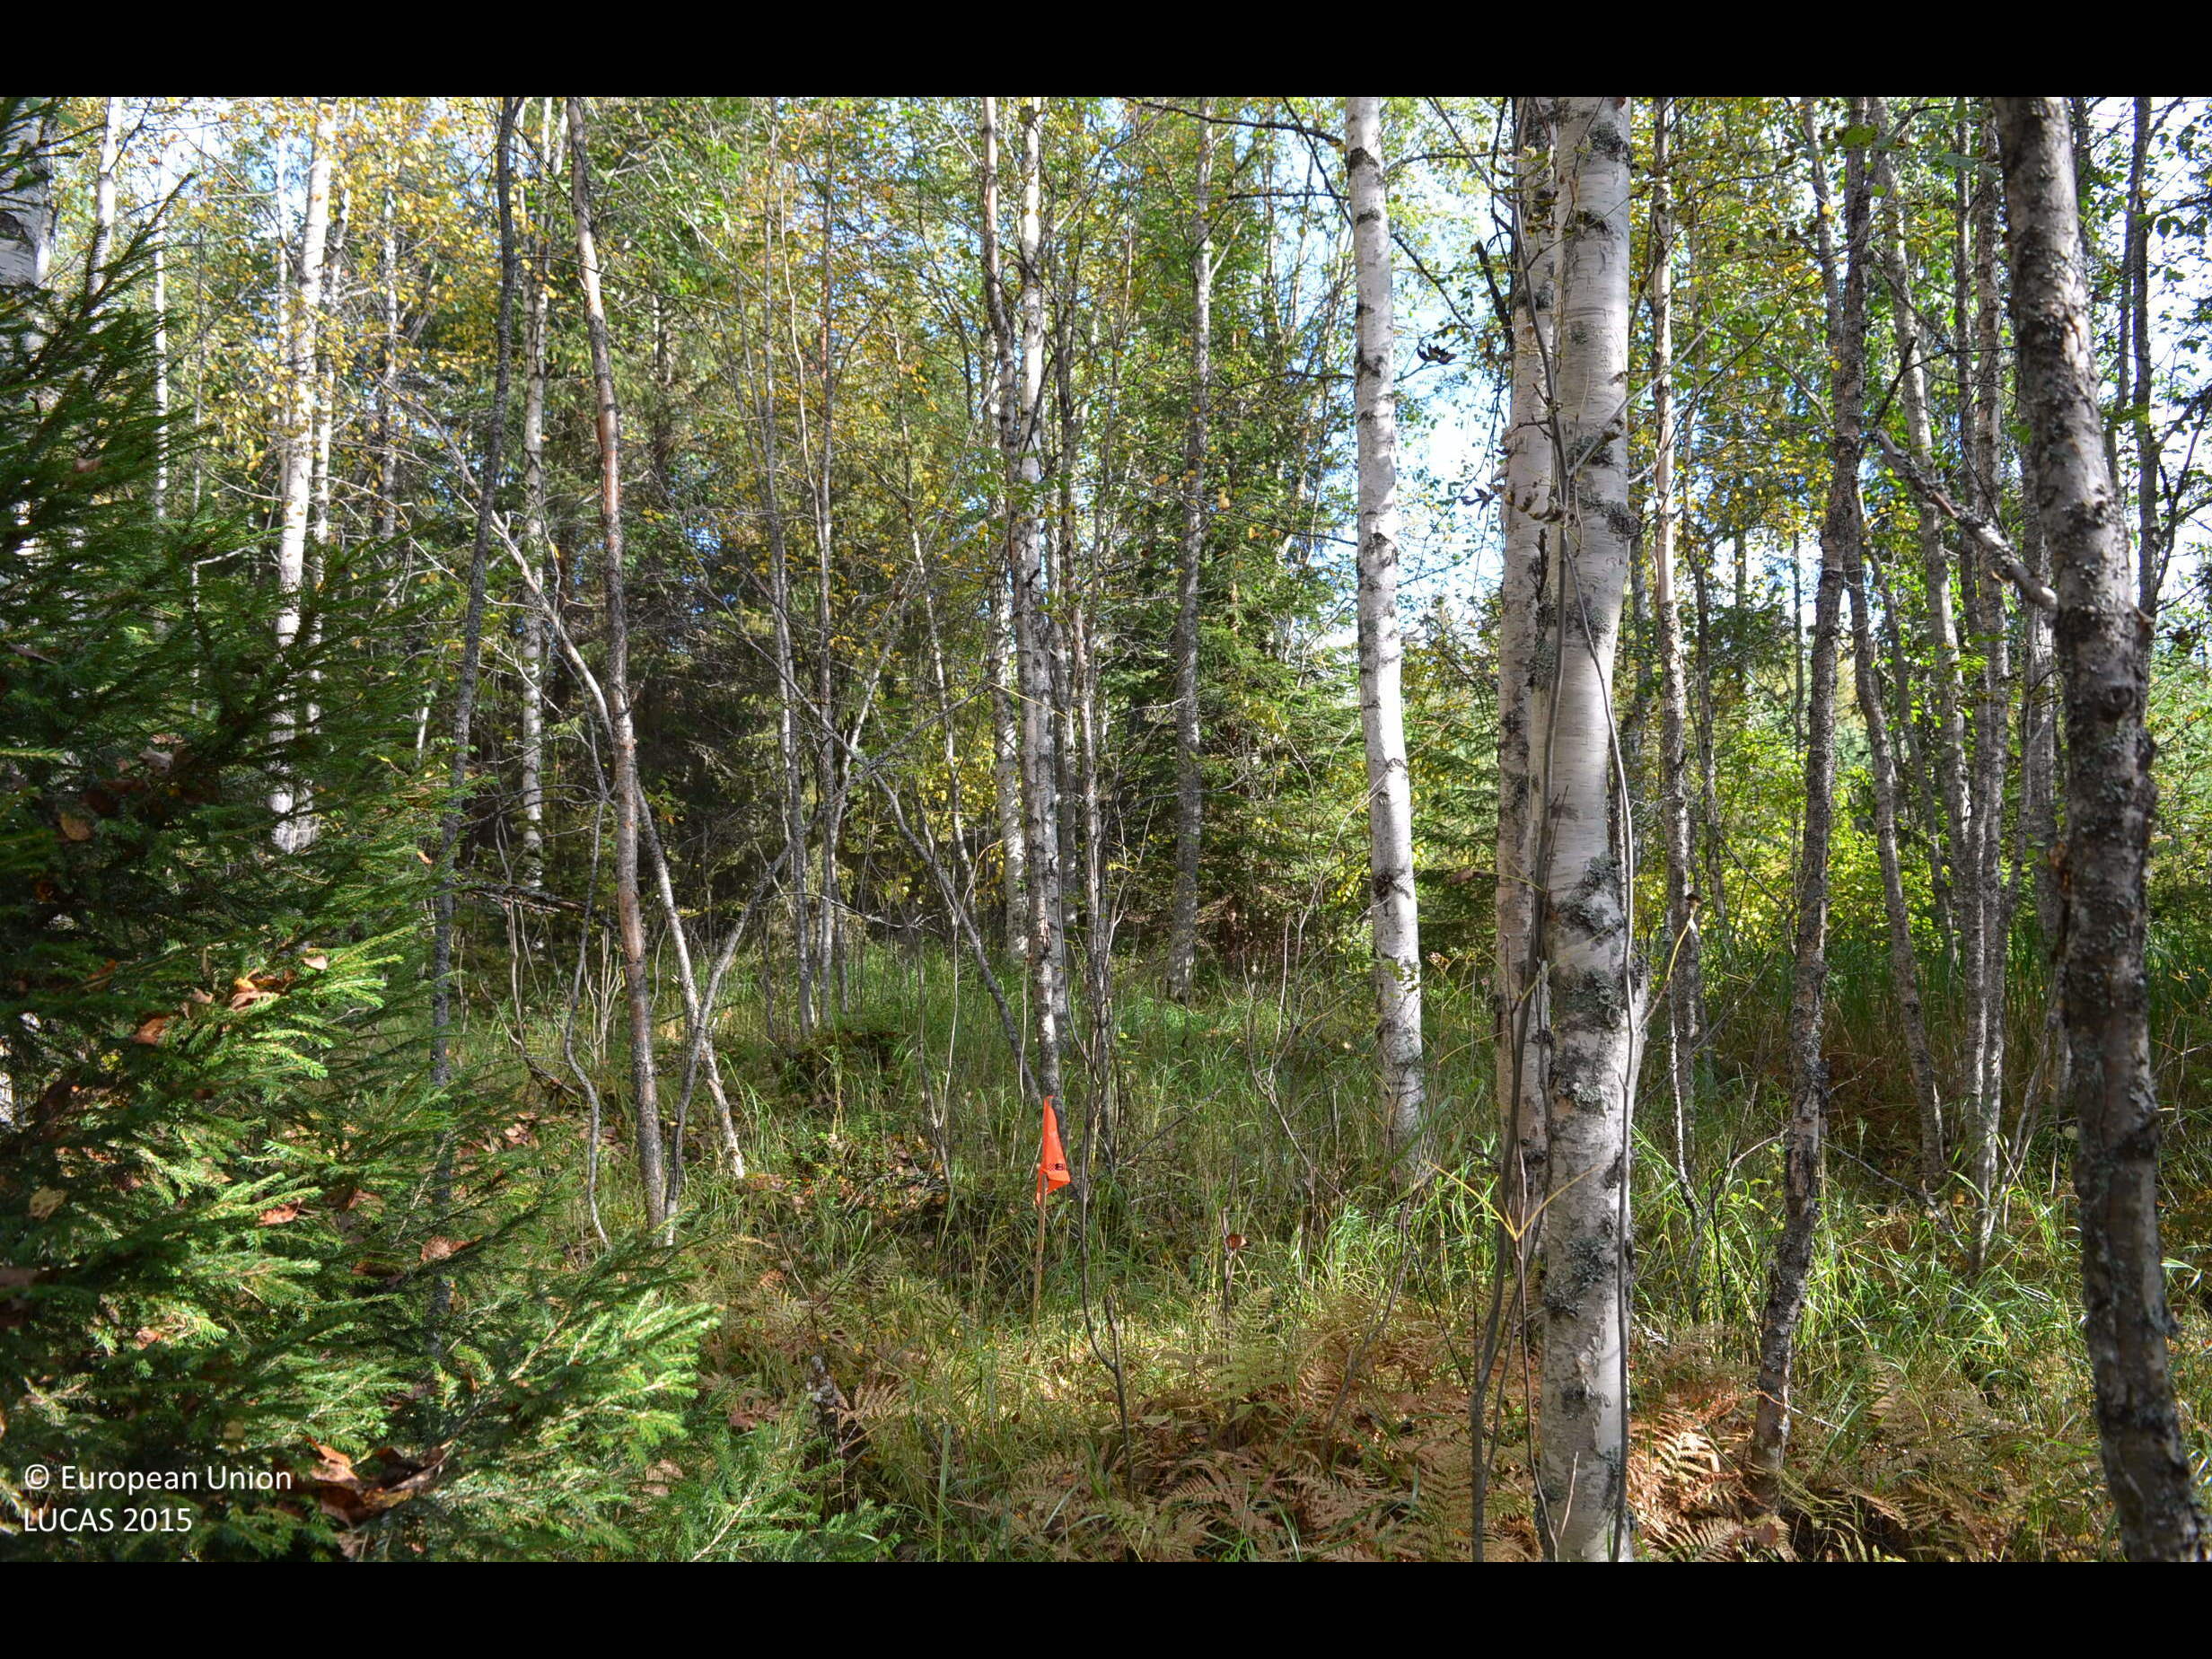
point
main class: Woodland
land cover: Spruce dominated mixed woodland
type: boreal forest
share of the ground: > 75 %
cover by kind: broadleaved forest trees 50 %, coniferous forest trees 25 %, herbaceous plants 20 %, shrubs 5 %
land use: Forestry
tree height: > 5 m
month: September
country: FI
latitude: 62.9277
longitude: 23.7998
